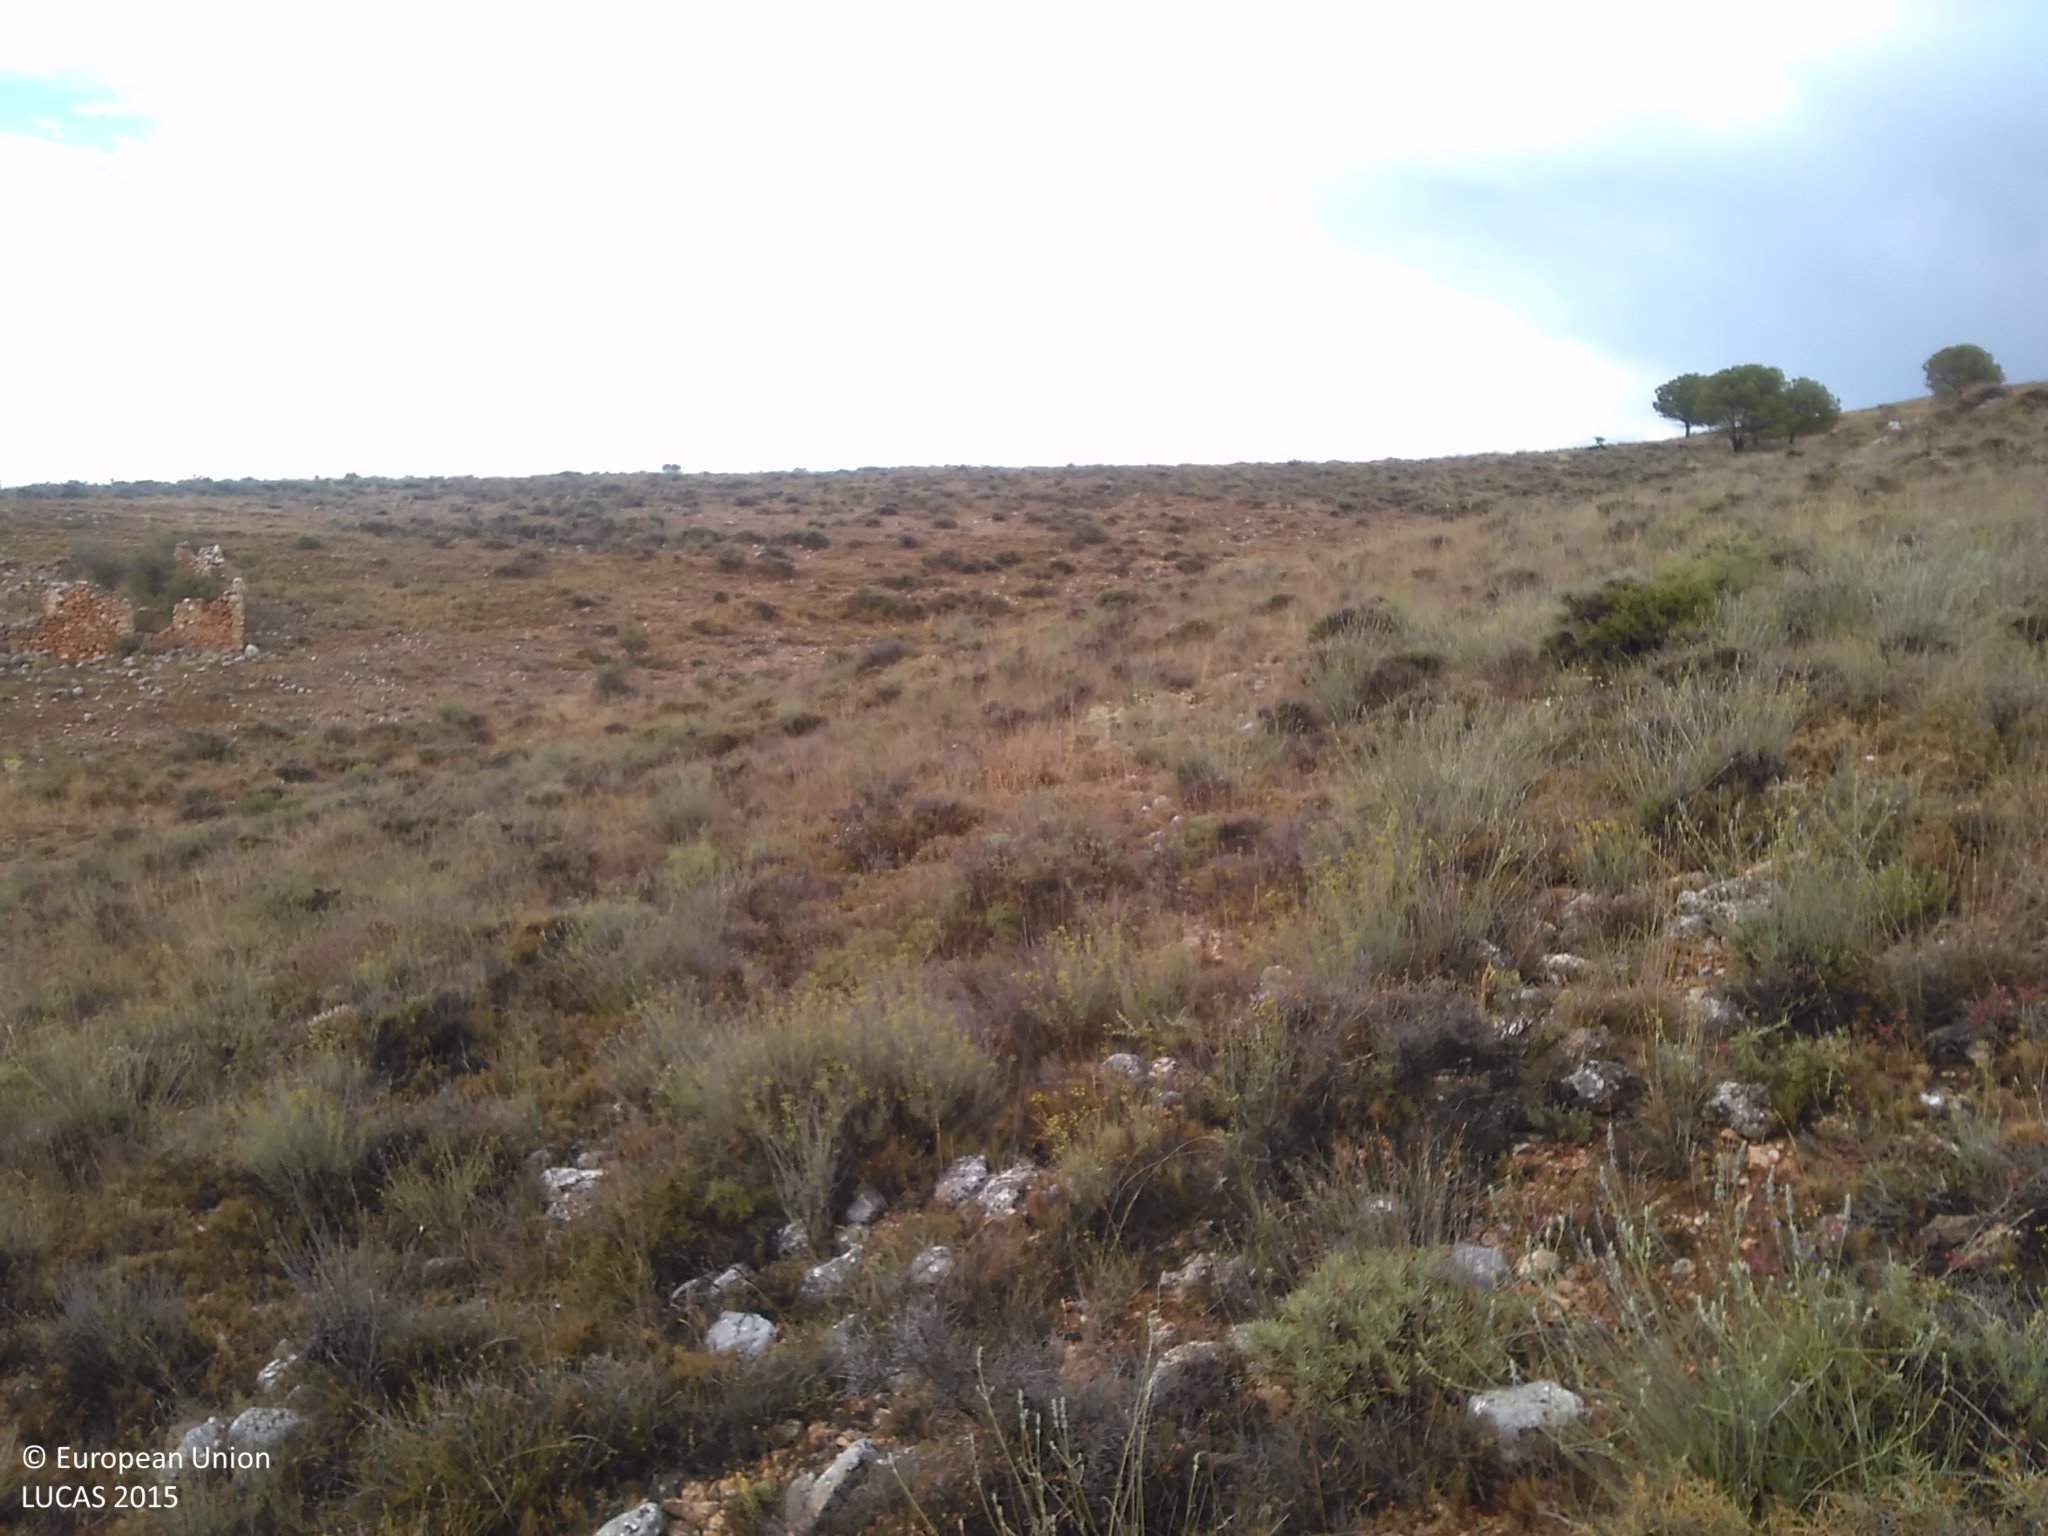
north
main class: Shrubland
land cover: Shrubland without tree cover
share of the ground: 50 - 75 %
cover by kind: shrubs 60 %, herbaceous plants 20 %, unconsolidated bare surface 20 %
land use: Semi-natural and natural areas not in use
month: July
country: ES
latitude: 41.4440
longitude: -2.0109
